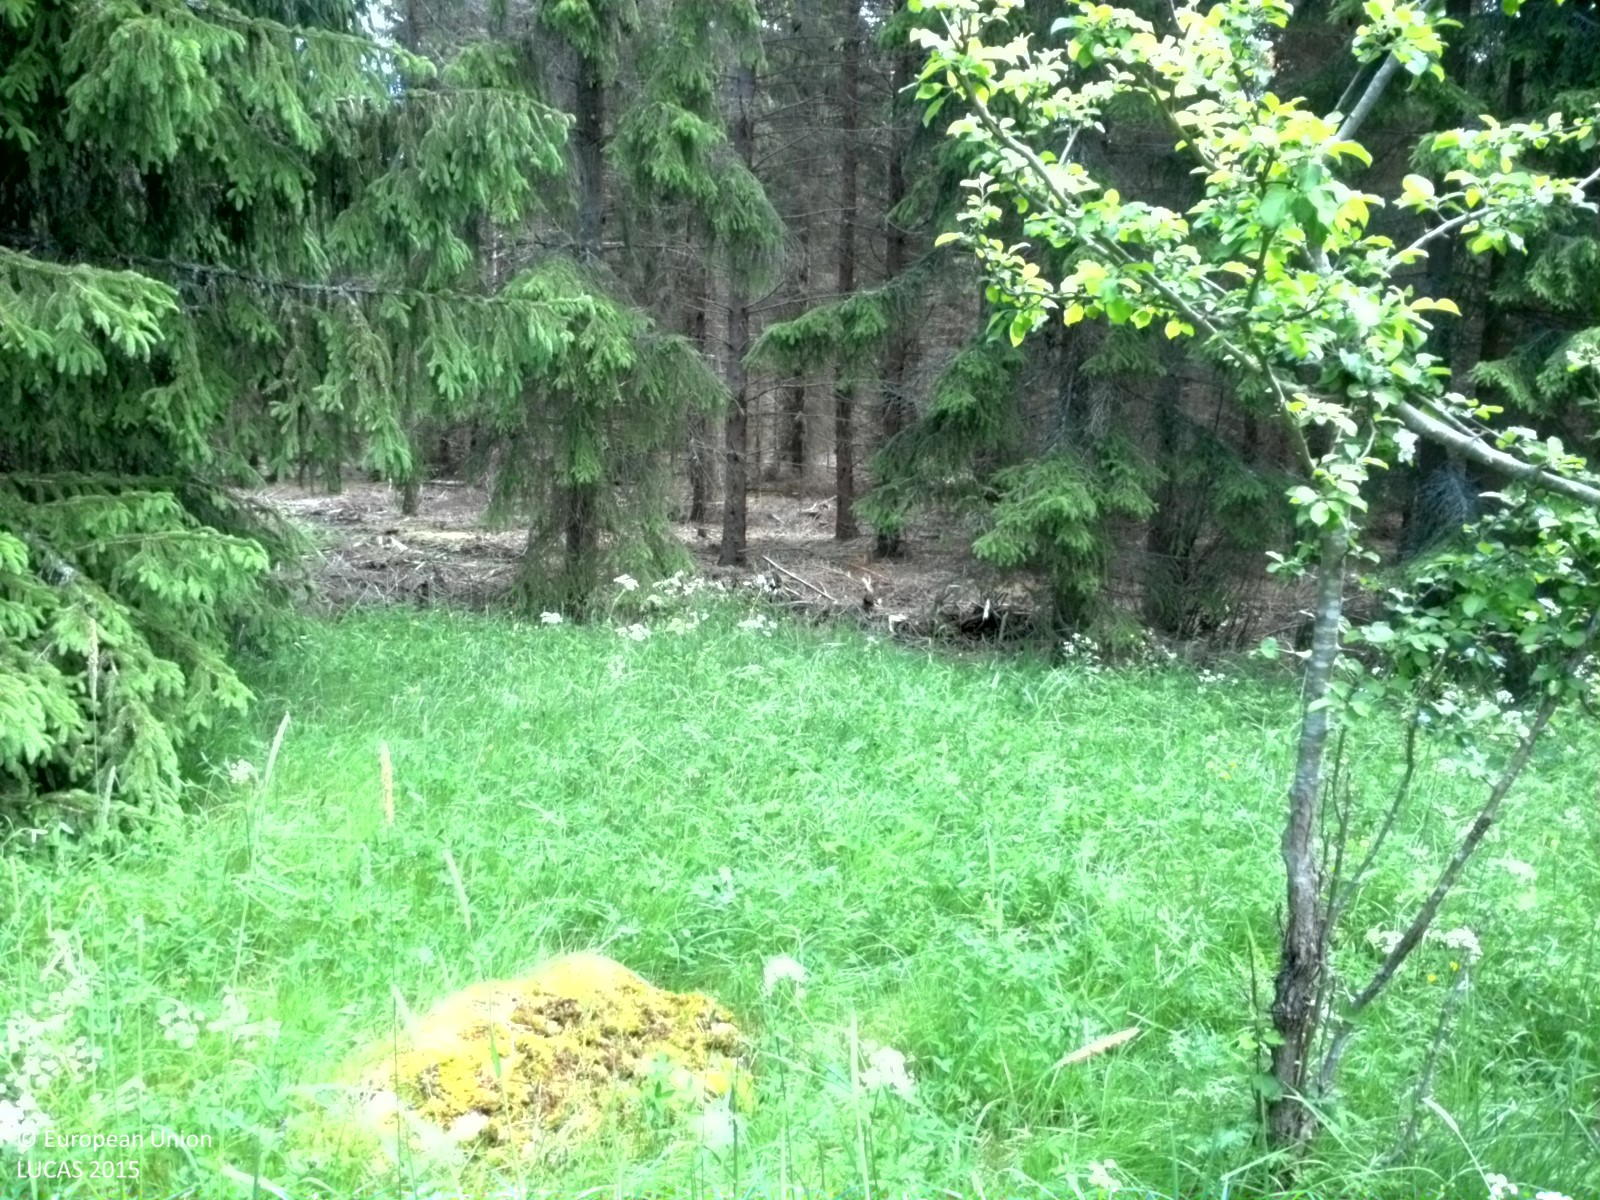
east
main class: Grassland
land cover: Grassland with sparse tree/shrub cover
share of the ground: > 75 %
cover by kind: herbaceous plants 90 %, broadleaved forest trees 5 %, shrubs 5 %
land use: Agriculture (excluding fallow land and kitchen gardens)
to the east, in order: Grassland with sparse tree/shrub cover; Spruce dominated coniferous woodland; Ditches and canals; Spruce dominated coniferous woodland
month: June
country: SE
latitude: 60.1838
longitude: 17.7644
